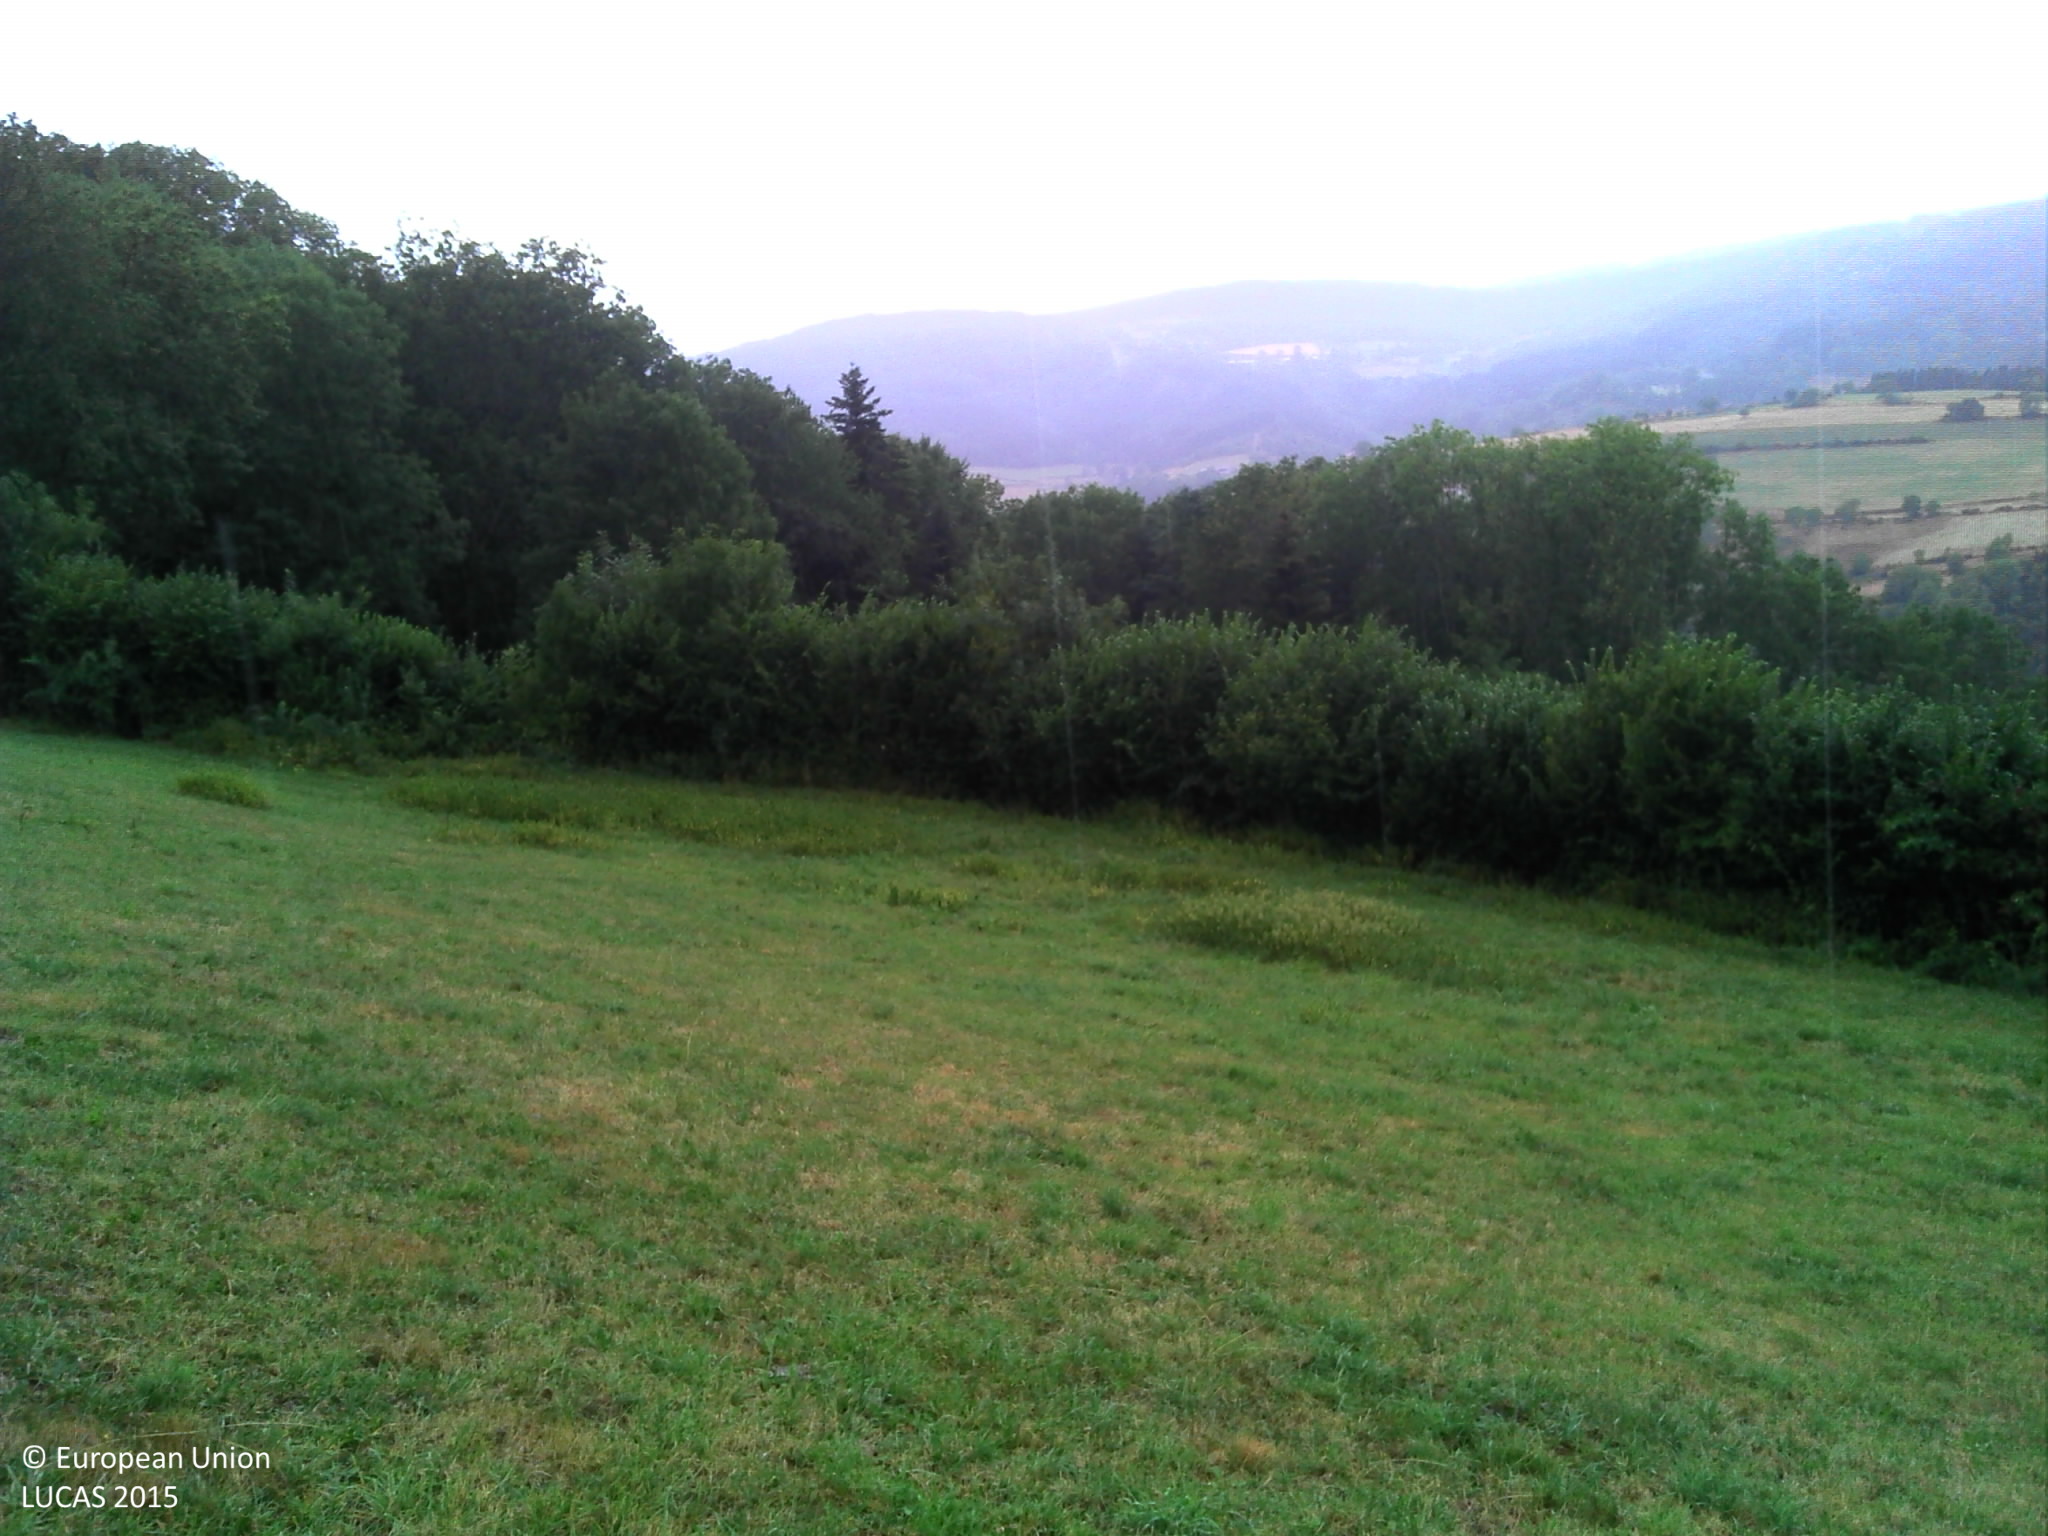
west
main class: Grassland
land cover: Grassland without tree/shrub cover
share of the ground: > 75 %
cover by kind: herbaceous plants 100 %
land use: Agriculture (excluding fallow land and kitchen gardens)
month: August
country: FR
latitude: 45.2713
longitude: 4.5108
